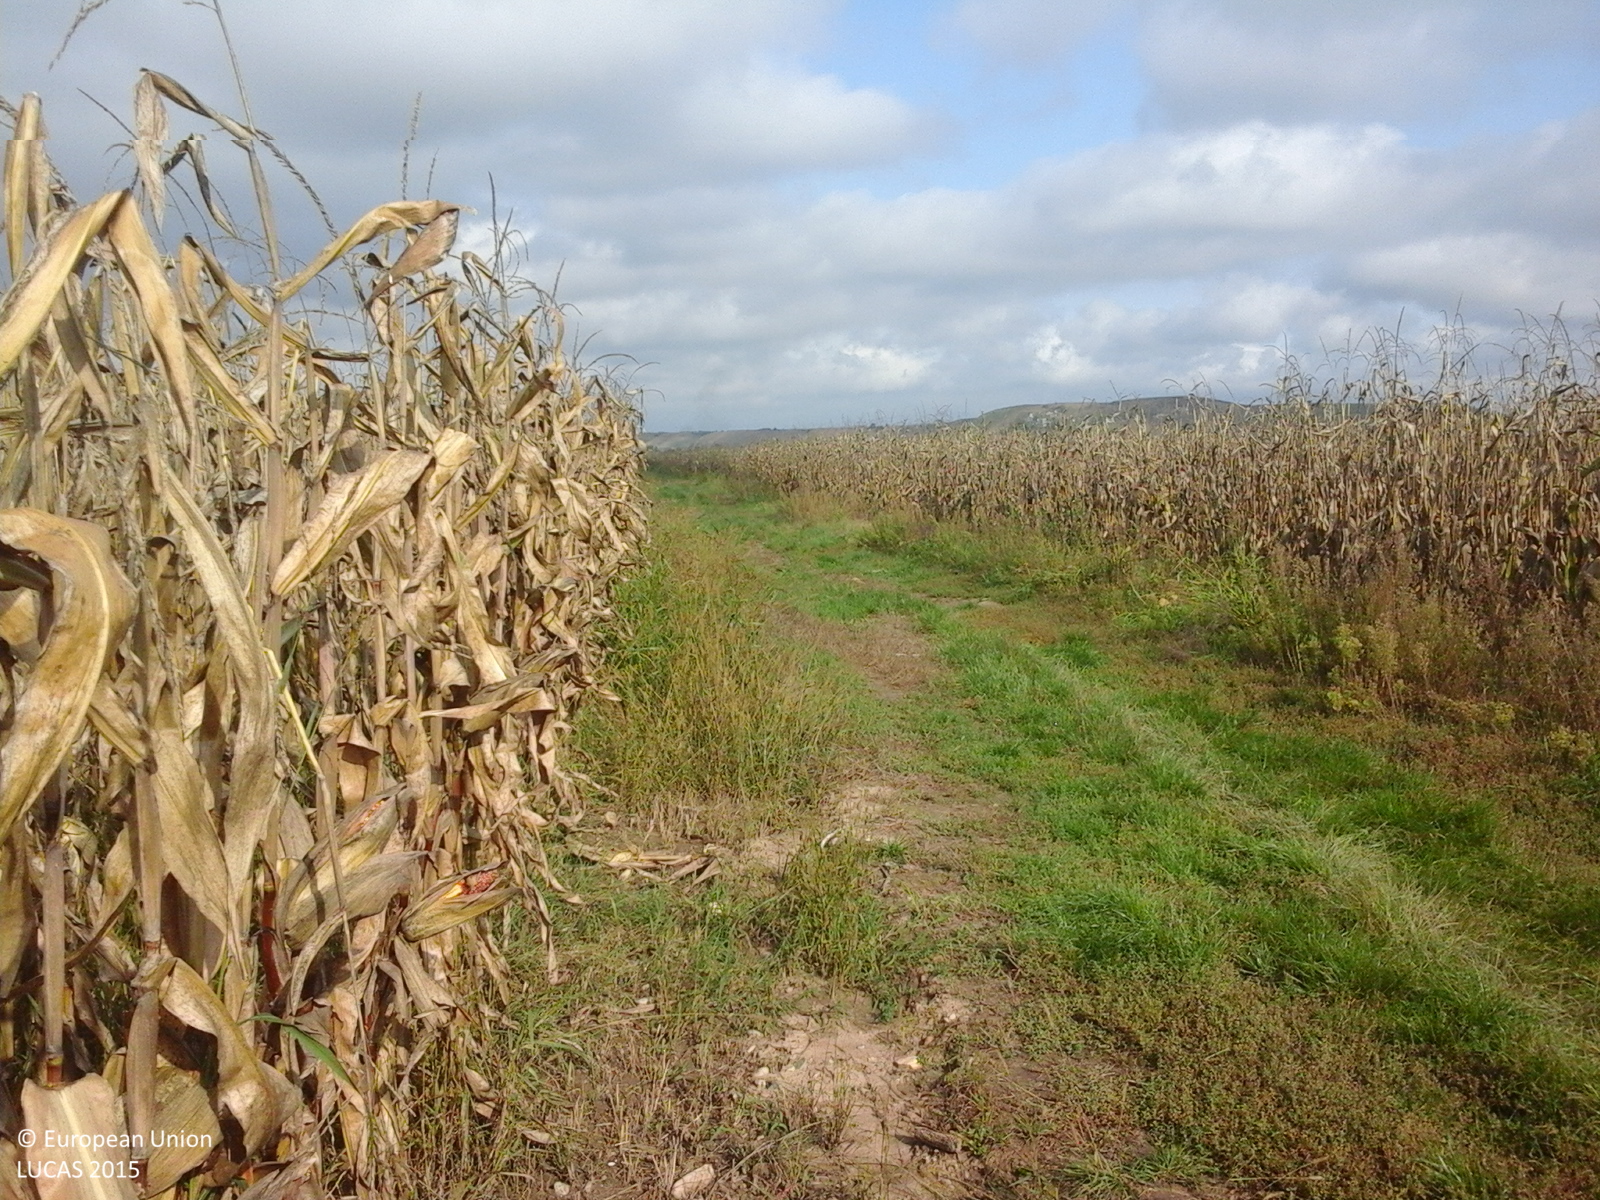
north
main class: Cropland
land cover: Maize
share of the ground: > 75 %
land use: Agriculture (excluding fallow land and kitchen gardens)
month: October
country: RO
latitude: 46.4170
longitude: 23.9577
